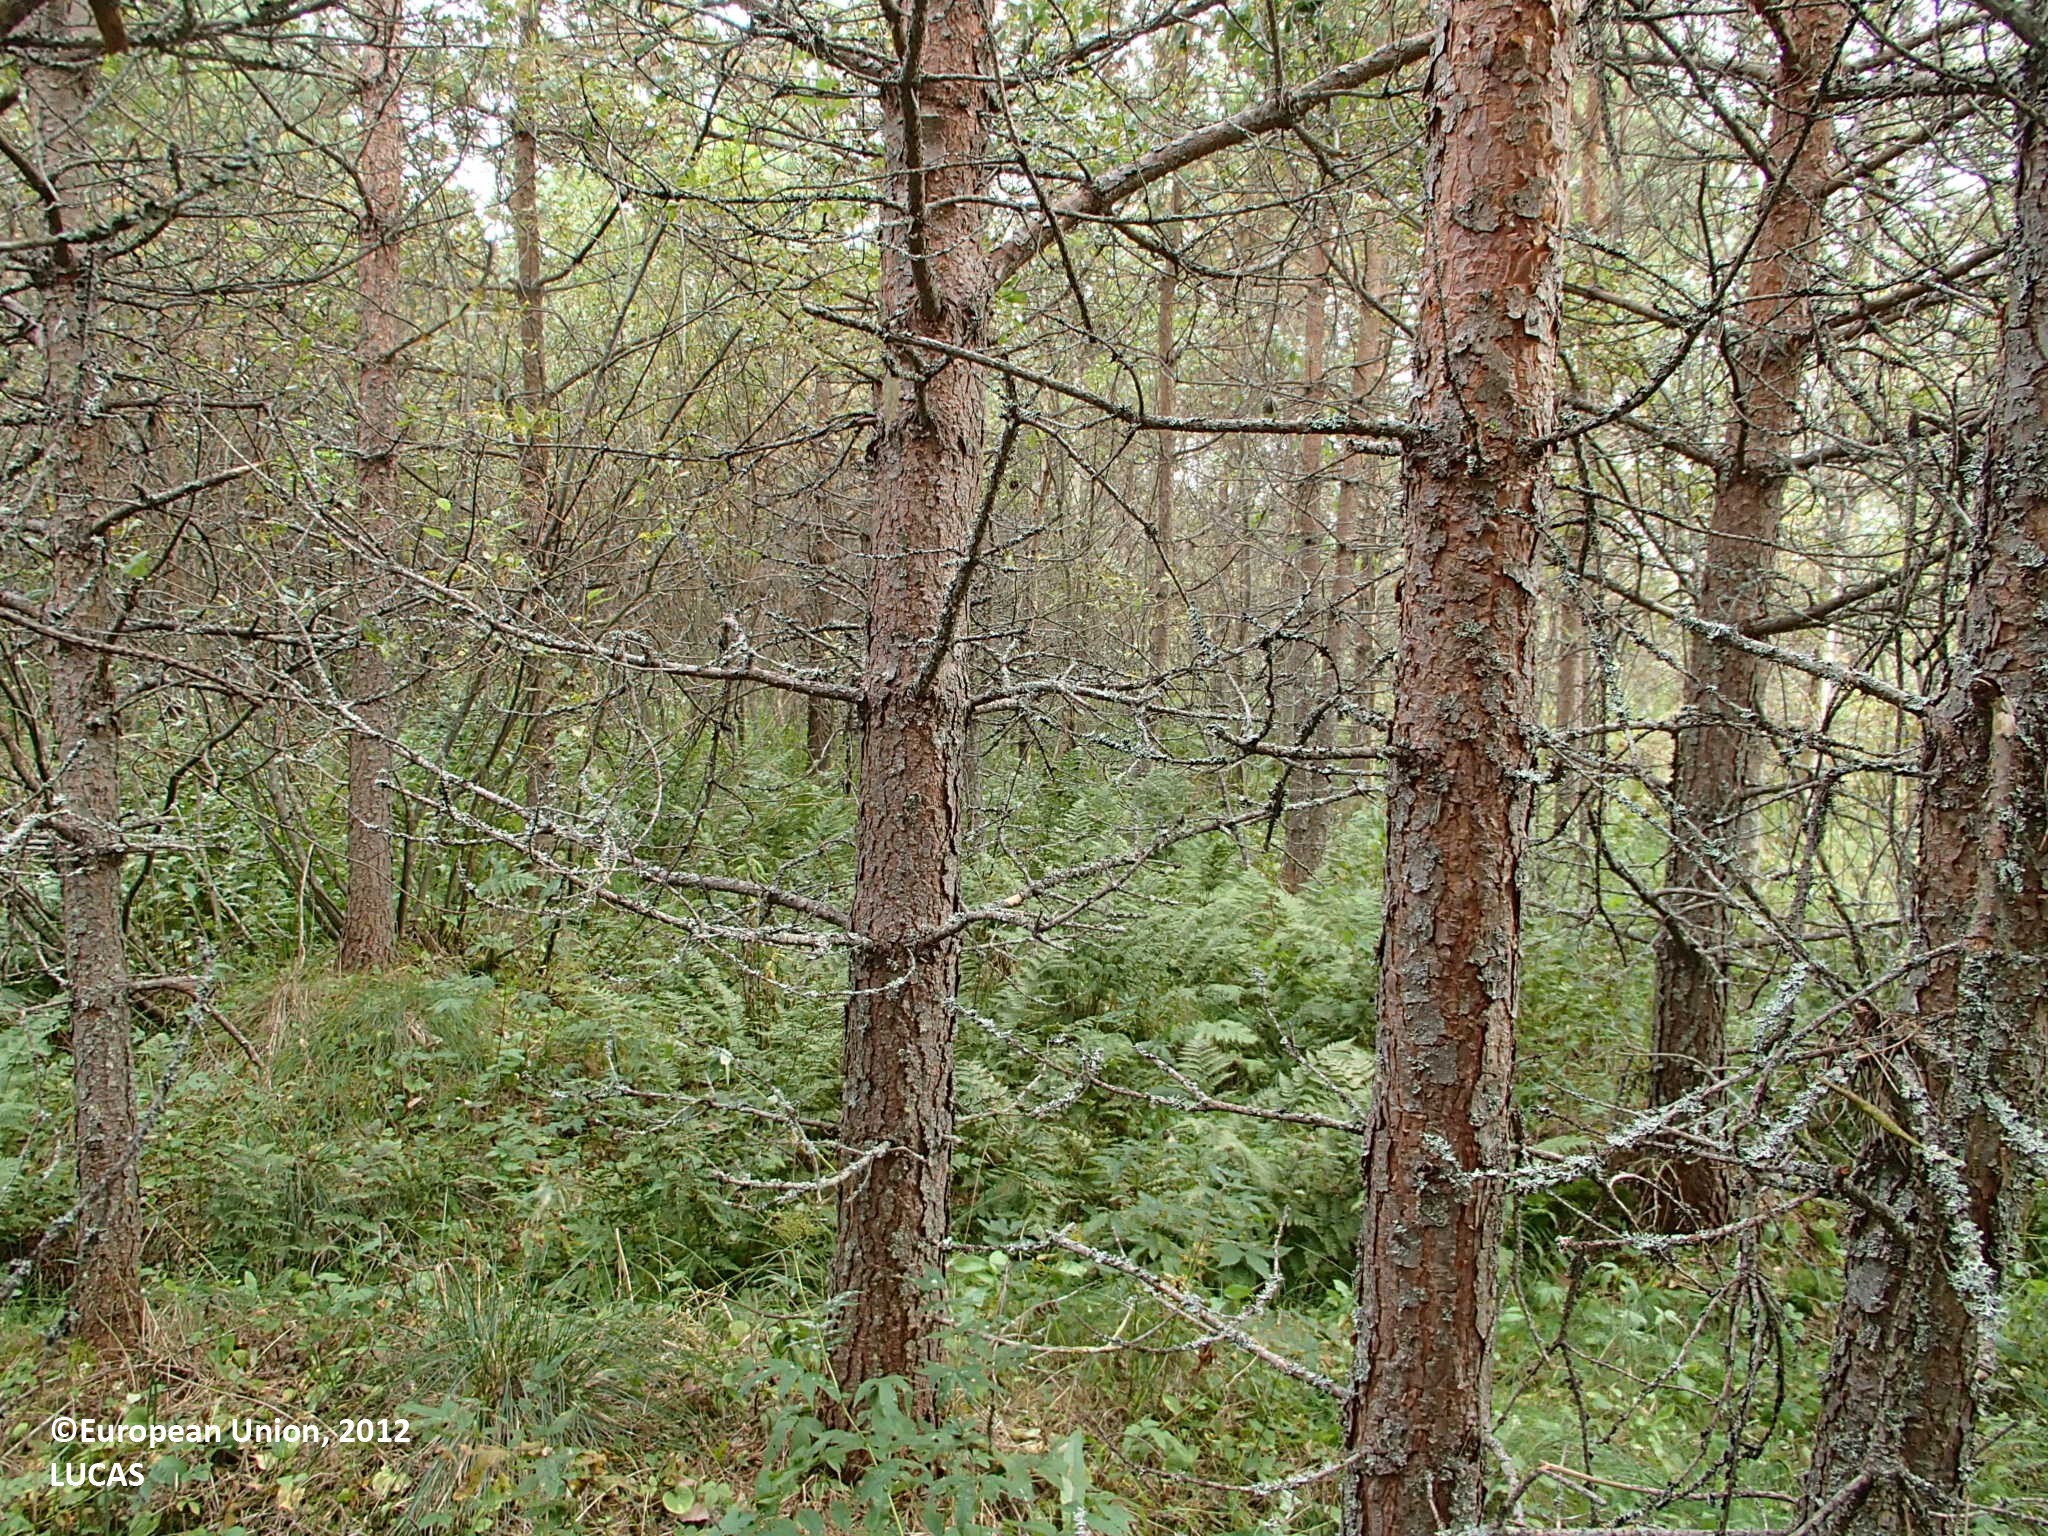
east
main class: Woodland
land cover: Pine dominated coniferous woodland
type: boreal forest
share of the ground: > 75 %
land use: Forestry
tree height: > 5 m
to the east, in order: Pine dominated coniferous woodland; Broadleaved woodland; Temporary grasslands; Ditches and canals; Broadleaved woodland
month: September
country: FI
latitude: 63.7433
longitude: 26.0155
